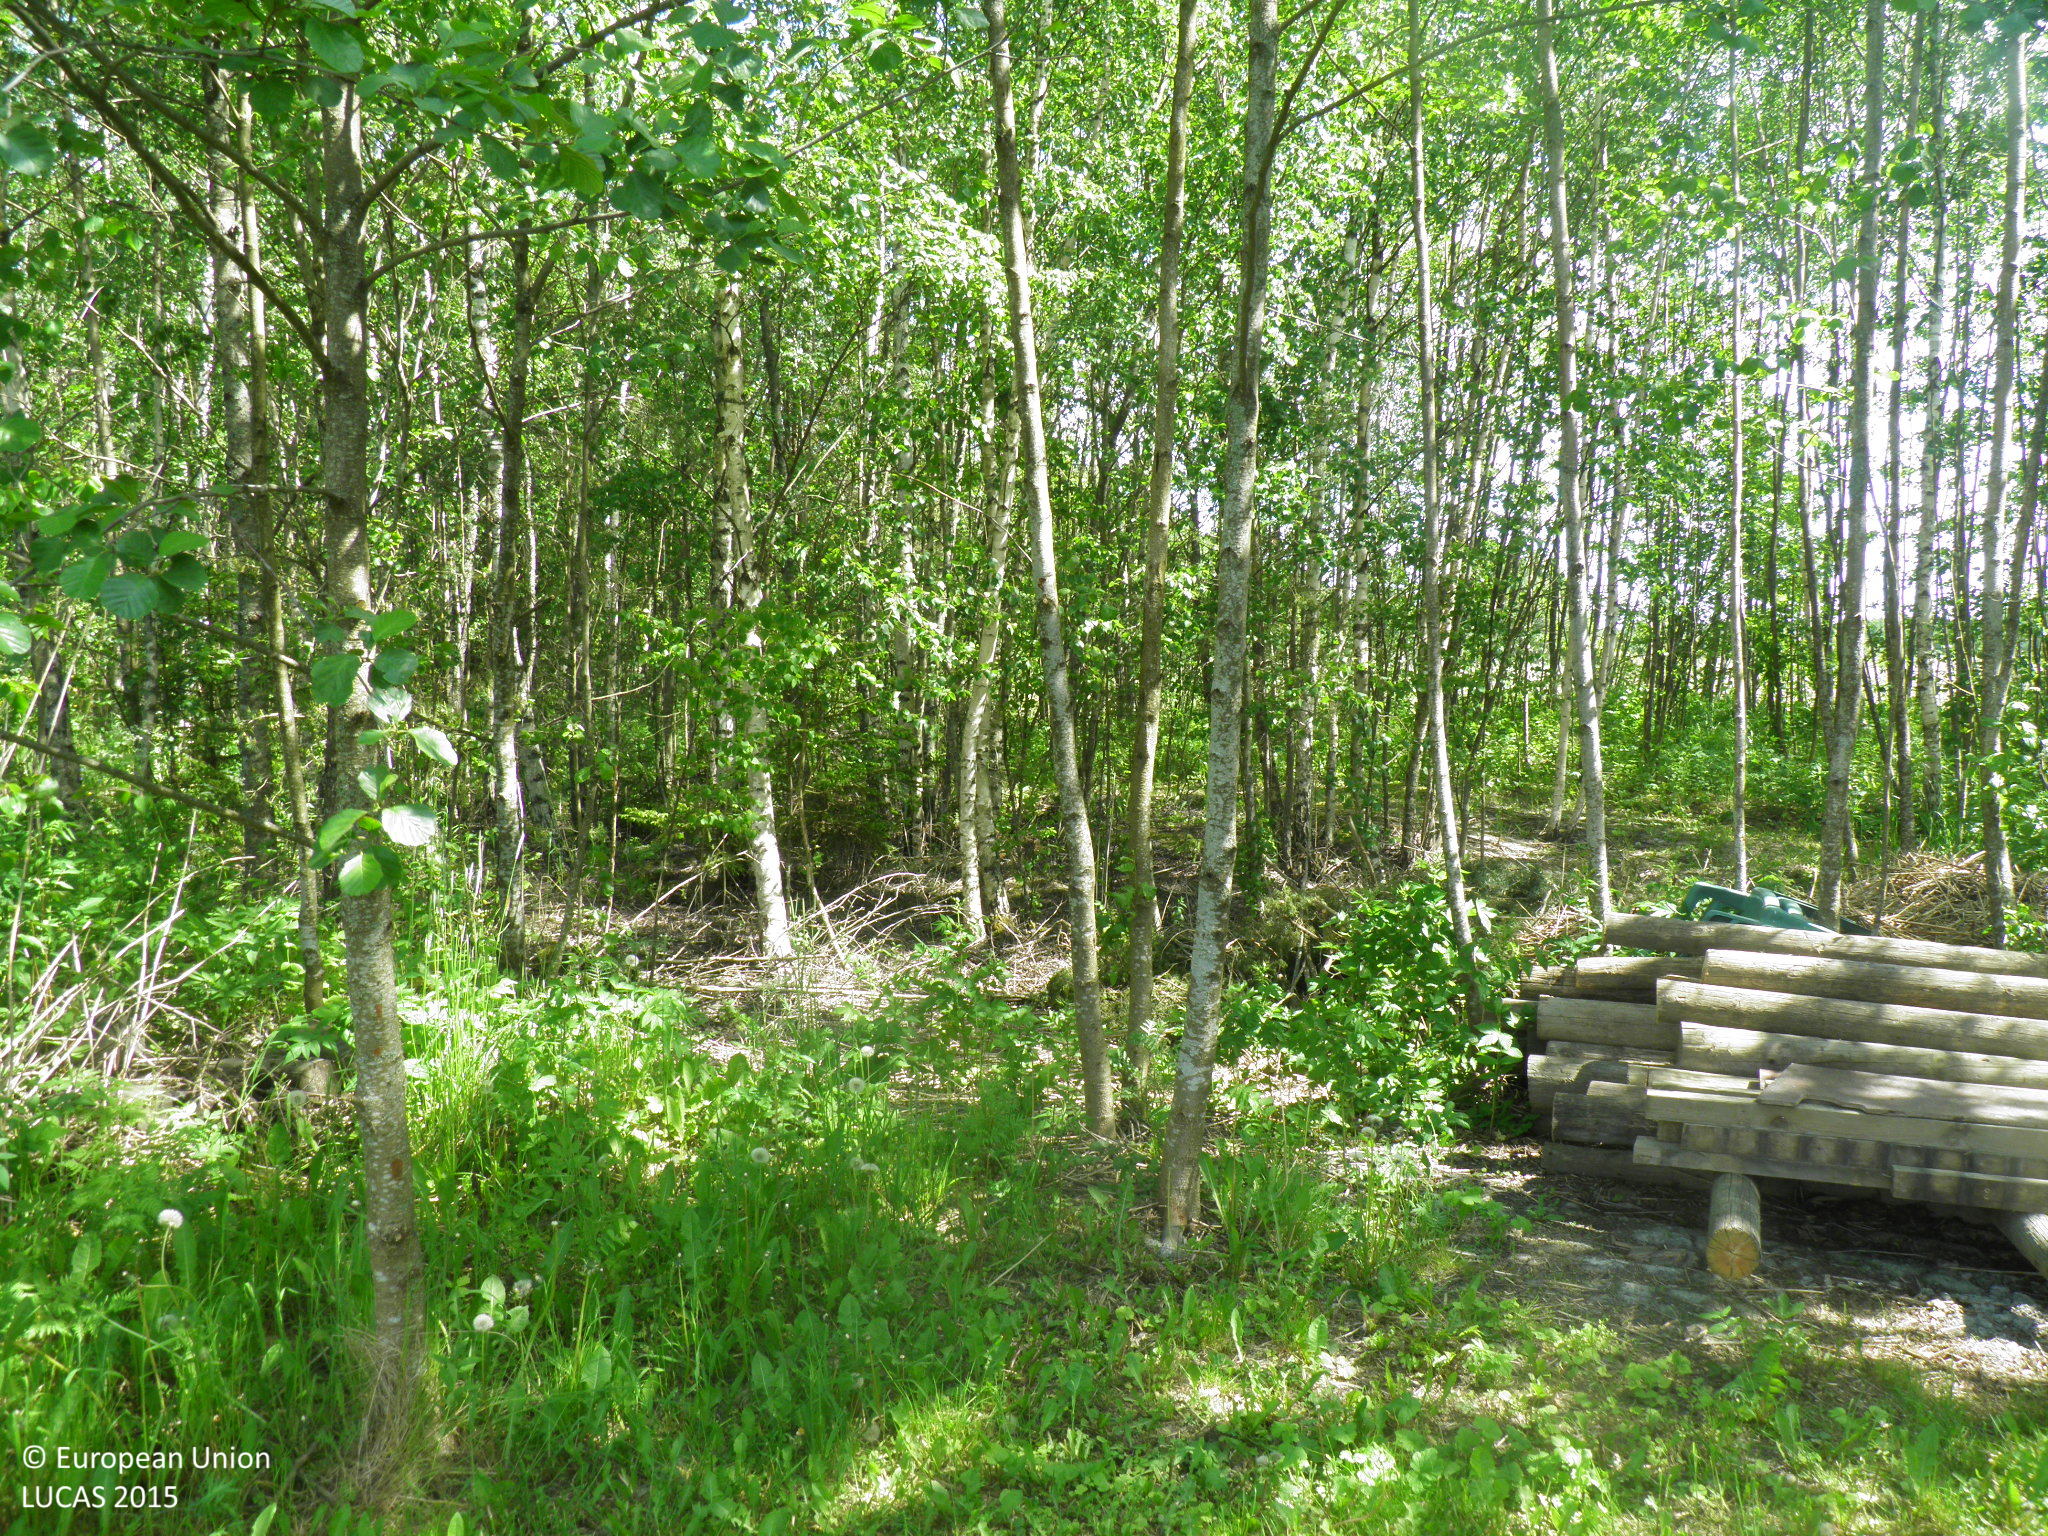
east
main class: Woodland
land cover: Broadleaved woodland
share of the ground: 50 - 75 %
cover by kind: broadleaved forest trees 55 %, herbaceous plants 45 %
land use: Amenities, museums, leisure
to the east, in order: Broadleaved woodland; Grassland without tree/shrub cover; Transitional water bodies; Grassland without tree/shrub cover; Broadleaved woodland; Grass margins; Artificial constructions in urban areas; Other bare soil; Ditches and canals; Broadleaved woodland
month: June
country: FI
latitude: 60.5567
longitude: 21.8235
